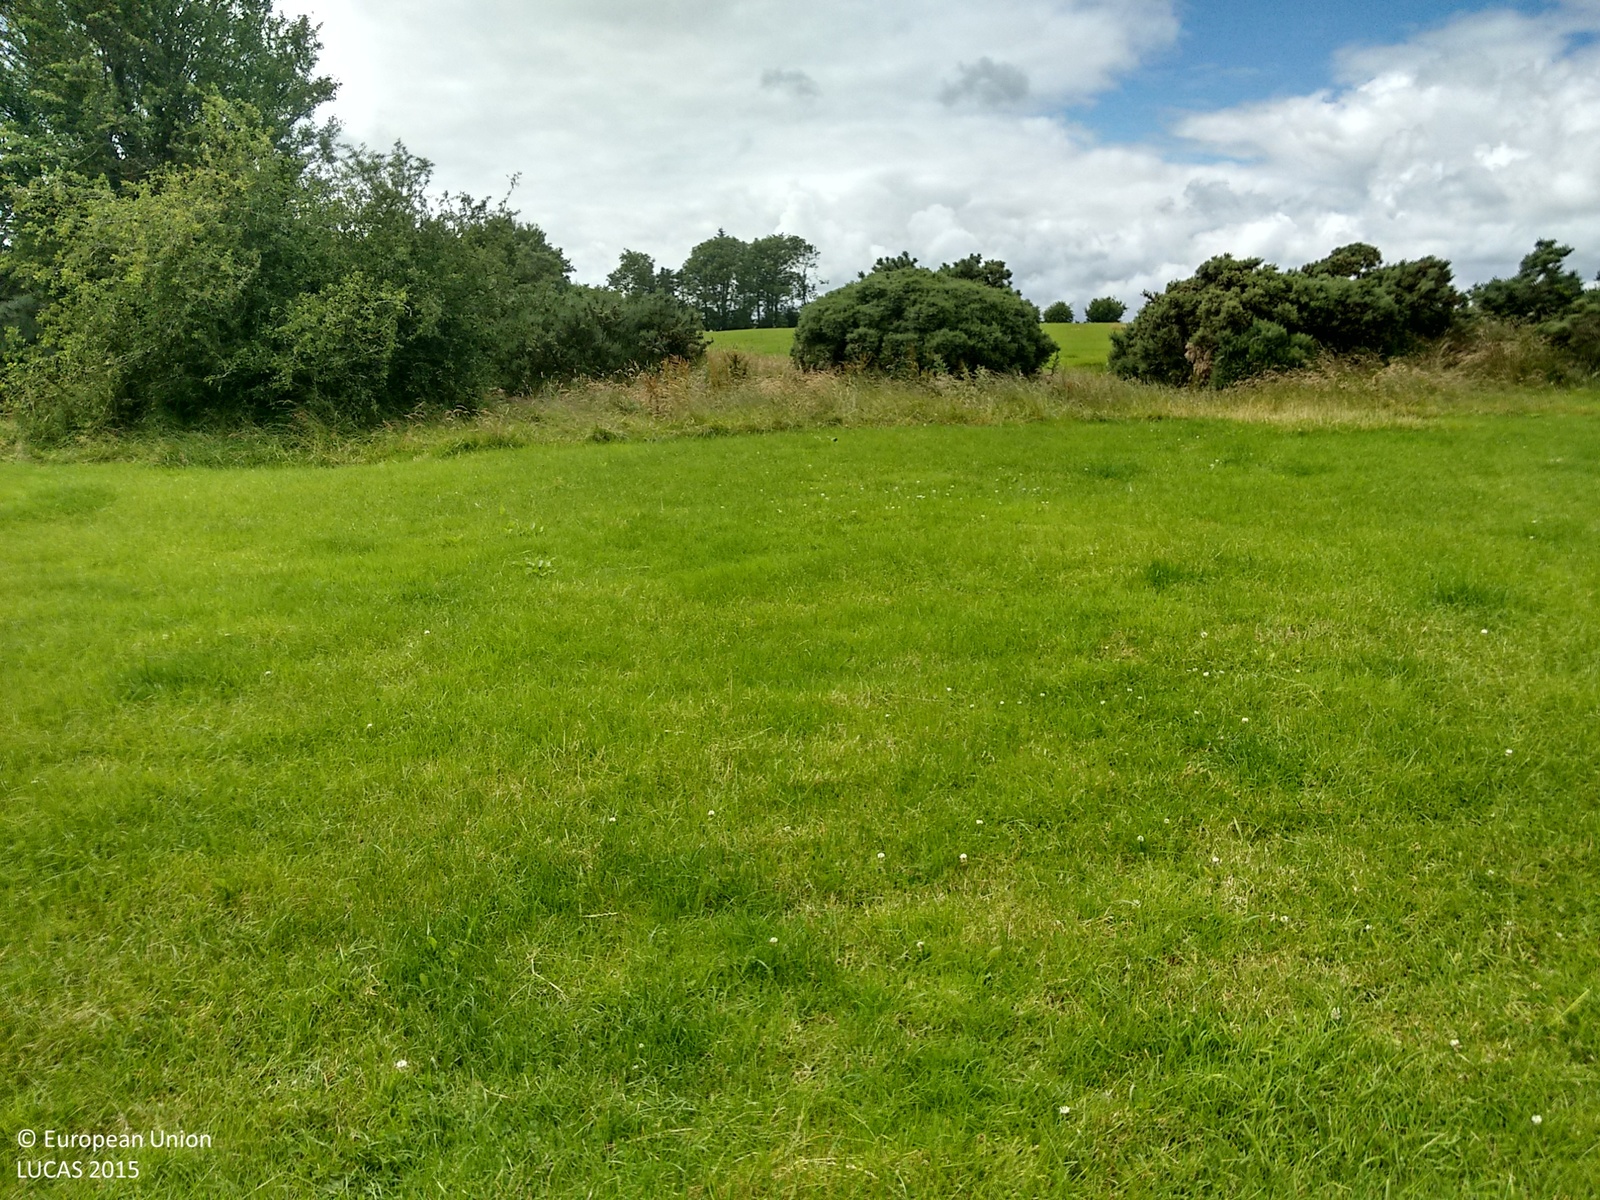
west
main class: Grassland
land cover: Grassland without tree/shrub cover
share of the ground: > 75 %
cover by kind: herbaceous plants 95 %, shrubs 5 %
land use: Agriculture (excluding fallow land and kitchen gardens)
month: July
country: IE
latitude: 52.2987
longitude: -8.9057
